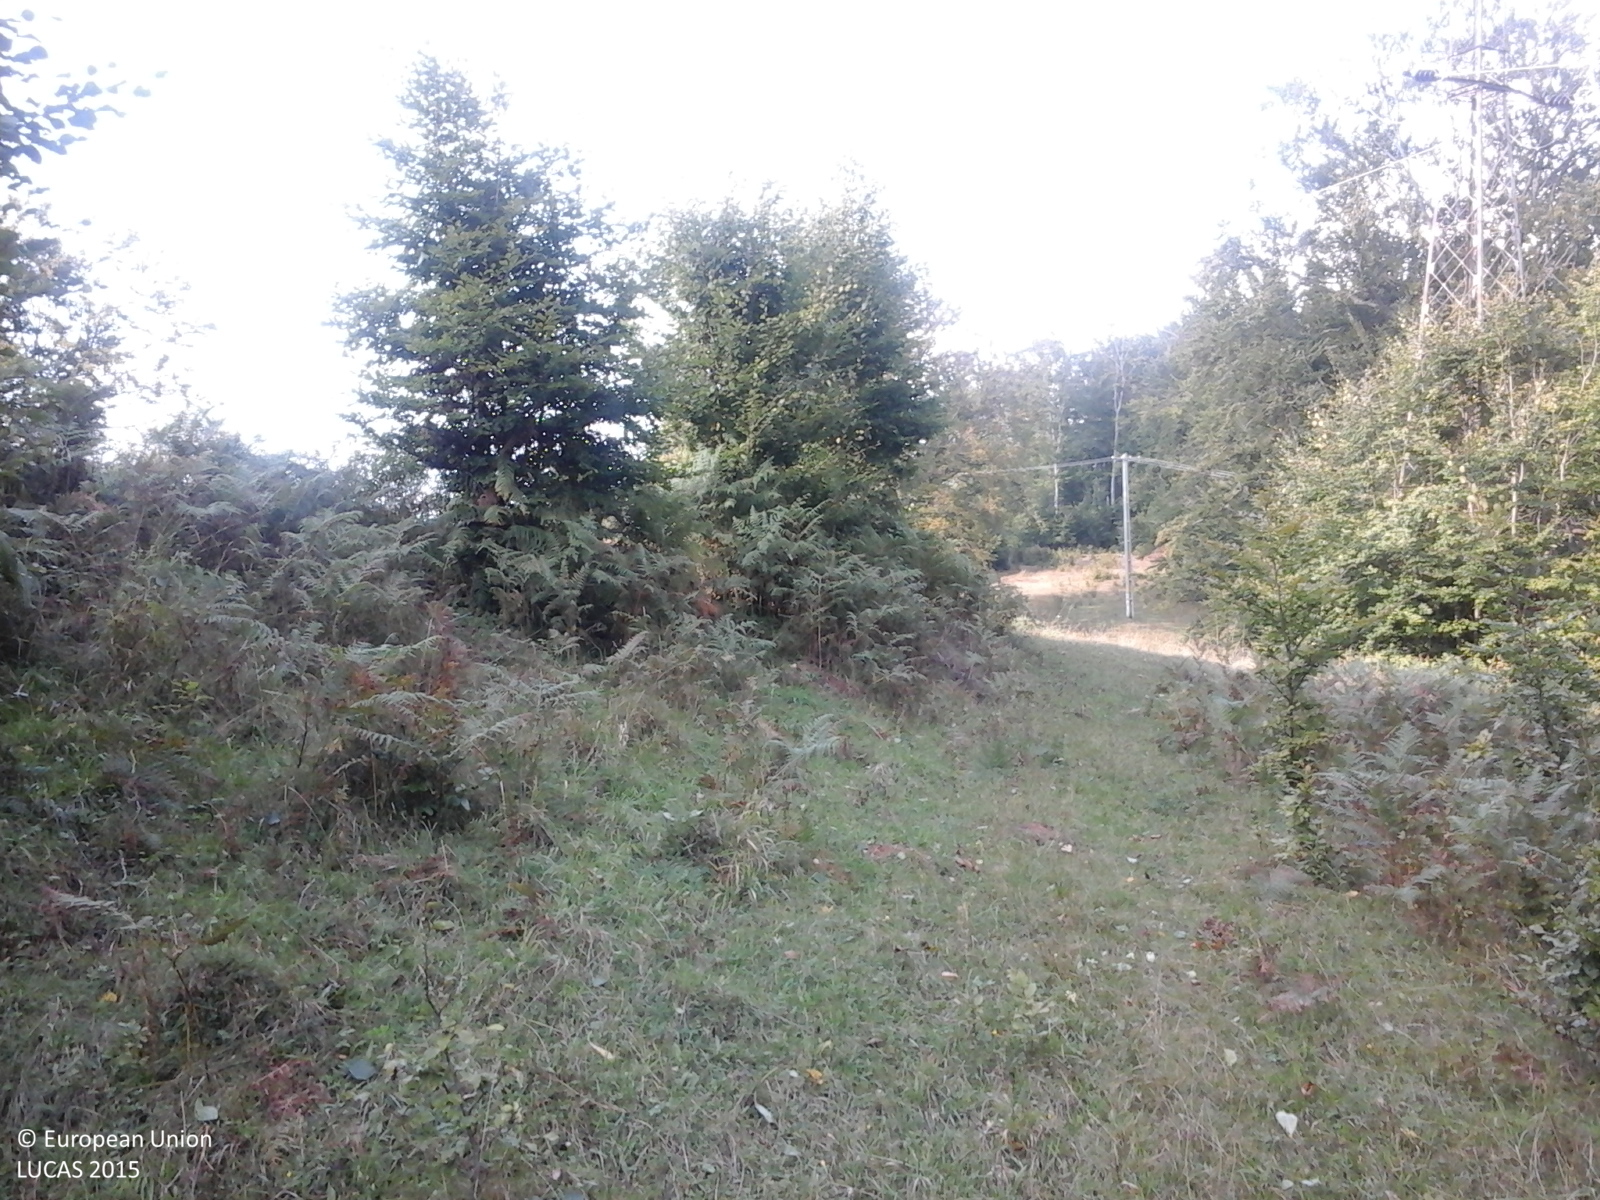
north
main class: Woodland
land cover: Broadleaved woodland
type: mesophytic deciduous forest
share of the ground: > 75 %
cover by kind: broadleaved forest trees 100 %
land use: Forestry
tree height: > 5 m
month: September
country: RO
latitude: 46.9089
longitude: 22.6466
